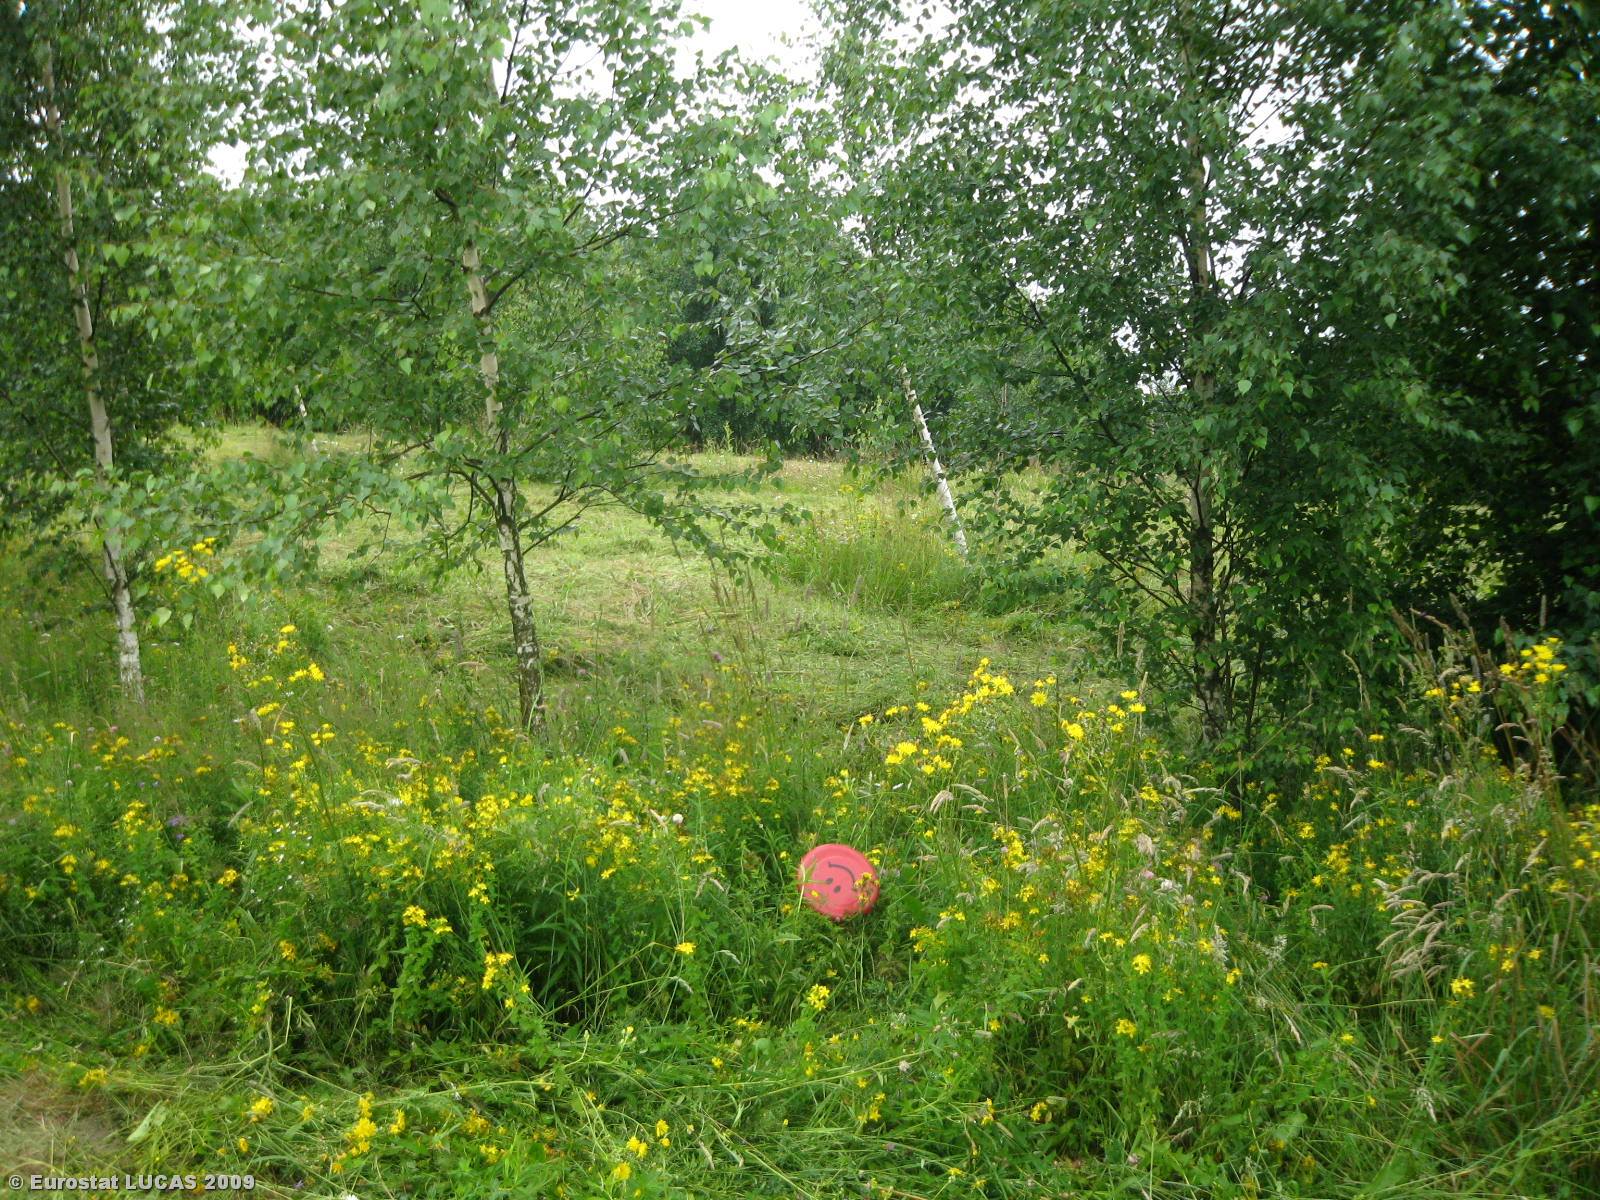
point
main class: Woodland
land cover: Broadleaved woodland
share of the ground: 25 - 50 %
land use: Forestry
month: July
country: LT
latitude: 55.2226
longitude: 24.8710
